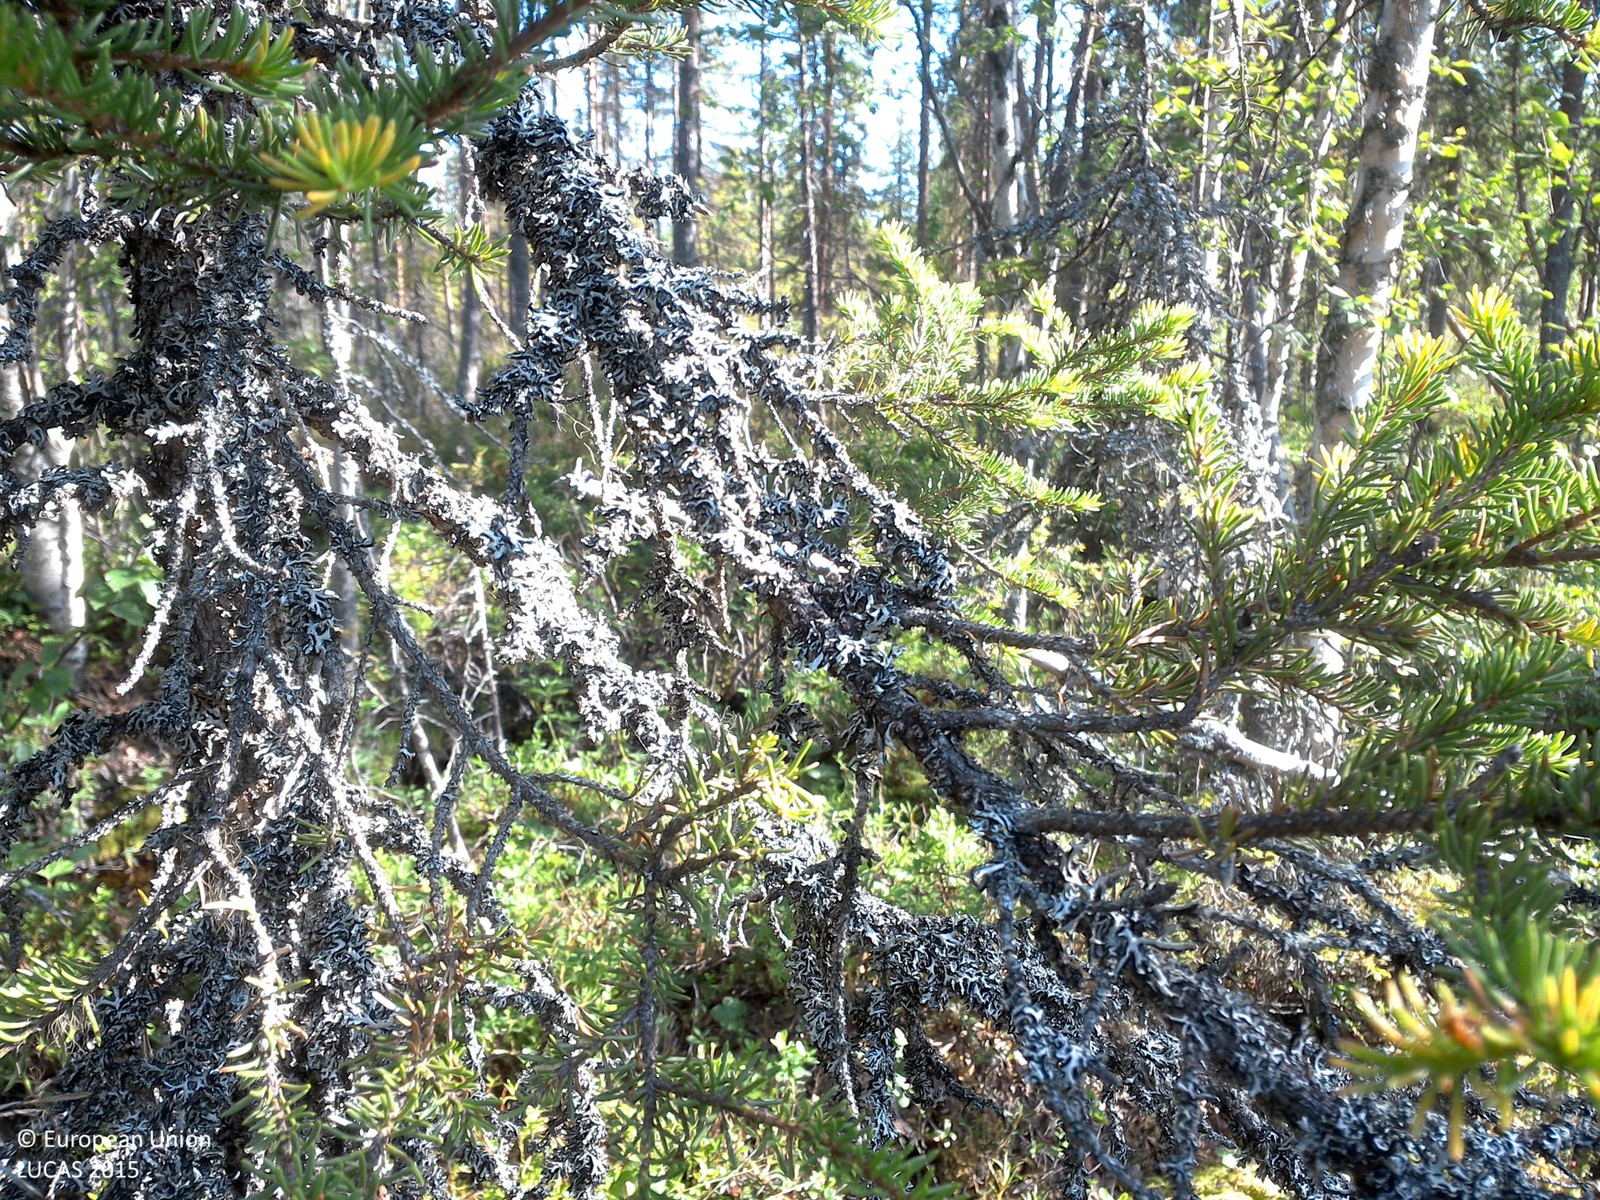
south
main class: Woodland
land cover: Pine dominated mixed woodland
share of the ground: 10 - 25 %
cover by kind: shrubs 45 %, herbaceous plants 20 %, coniferous forest trees 15 %, lichens and mosses 15 %, broadleaved forest trees 5 %
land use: Forestry
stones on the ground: < 10 %
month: July
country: SE
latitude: 67.2667
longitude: 22.6938
